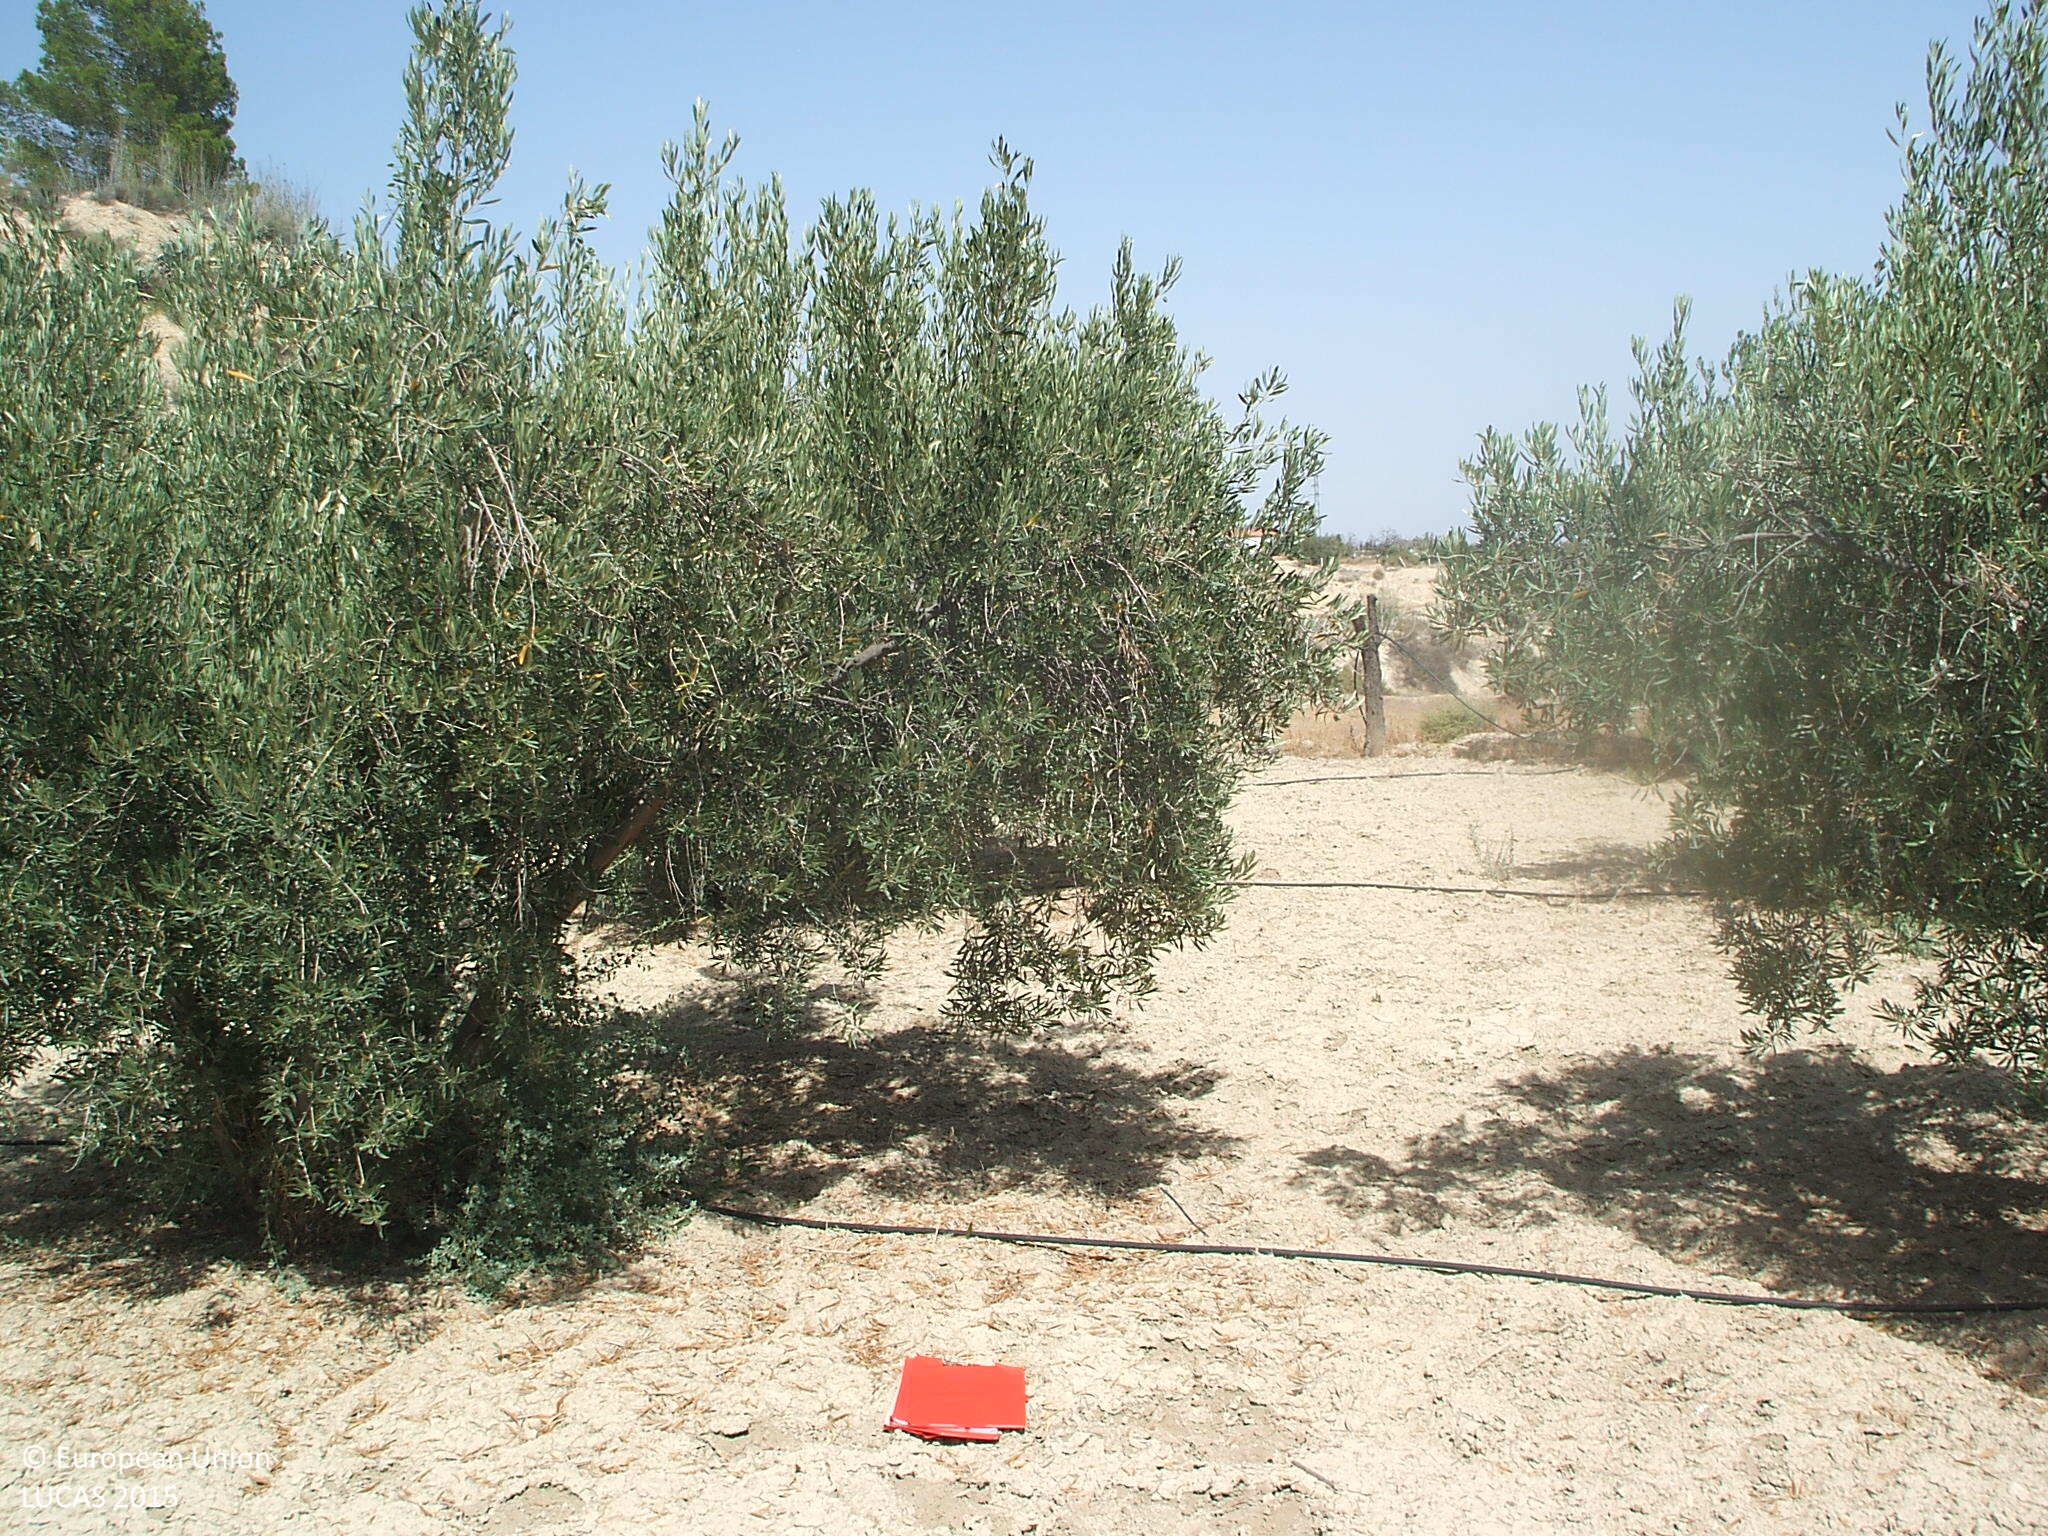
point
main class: Cropland
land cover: Olive groves
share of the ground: 50 - 75 %
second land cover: Other bare soil
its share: > 75 %
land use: Agriculture (excluding fallow land and kitchen gardens)
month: July
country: ES
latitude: 37.3821
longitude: -2.3264
